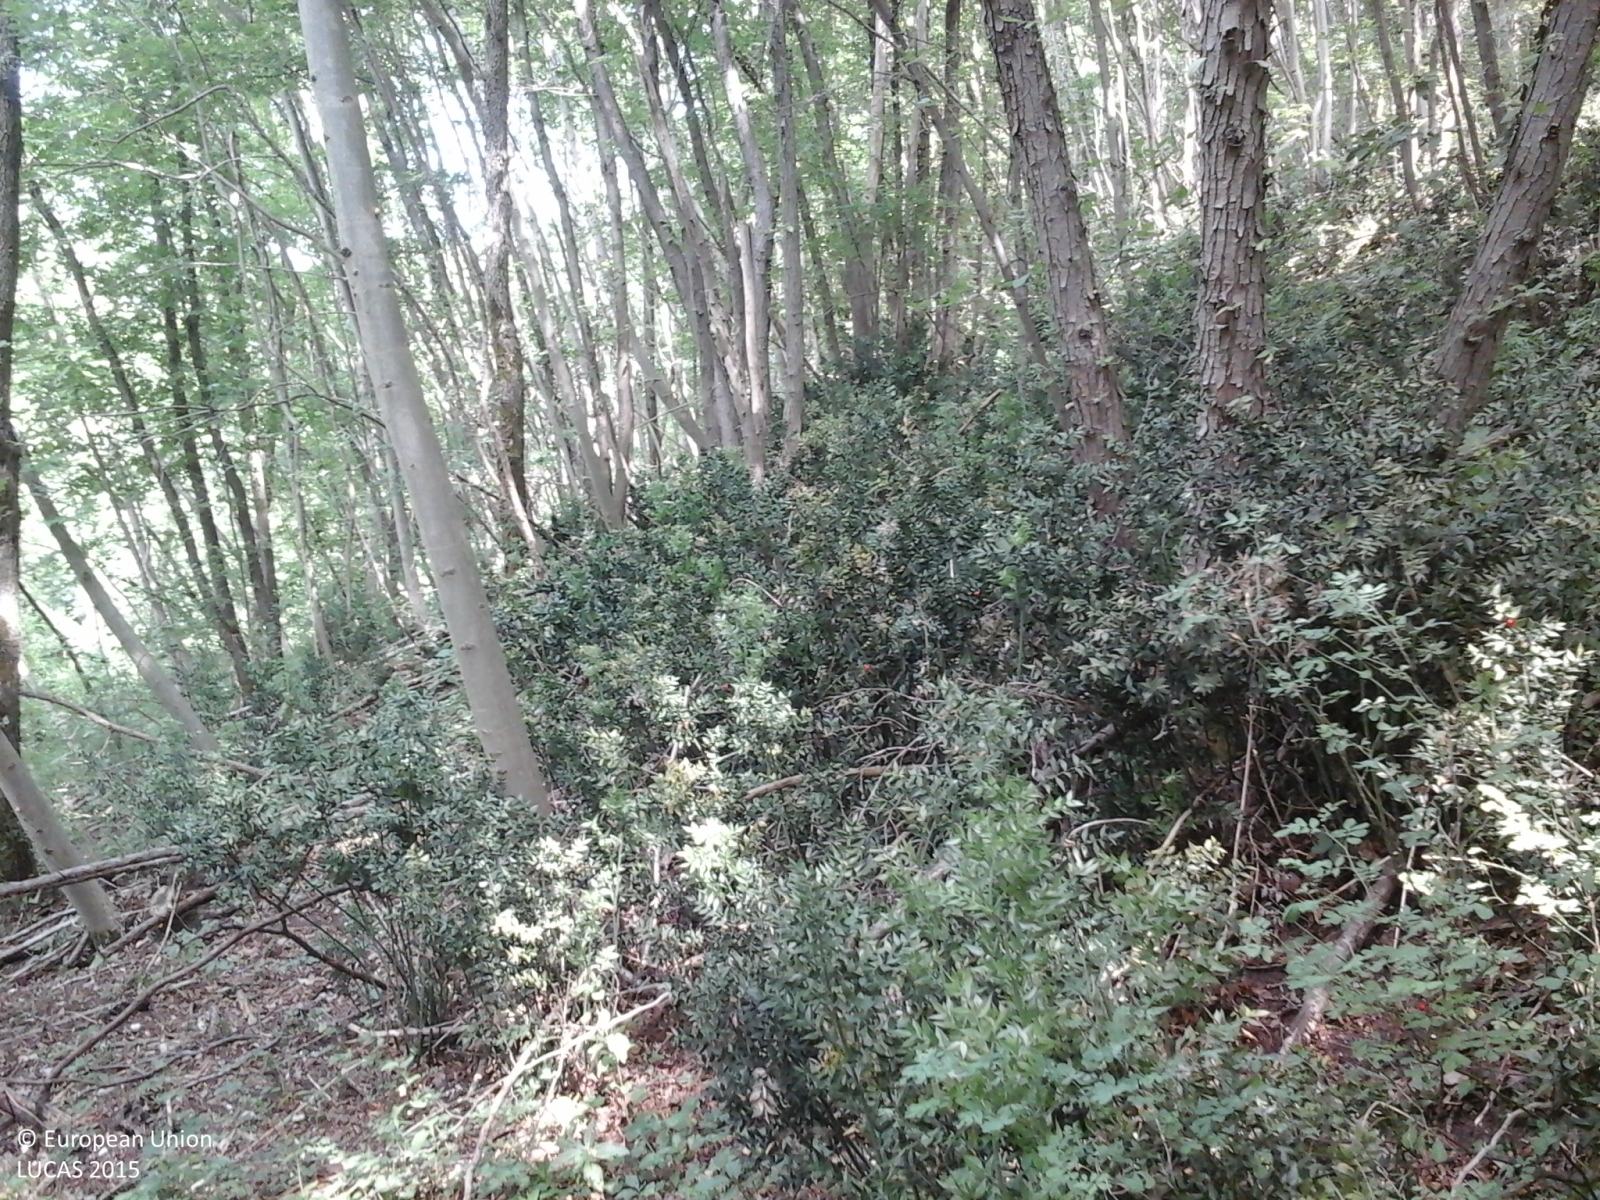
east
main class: Woodland
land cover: Broadleaved woodland
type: thermophilous deciduous forest
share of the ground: > 75 %
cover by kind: broadleaved forest trees 100 %
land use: Semi-natural and natural areas not in use
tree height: > 5 m
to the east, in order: Broadleaved woodland
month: June
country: IT
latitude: 45.2925
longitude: 11.6929
